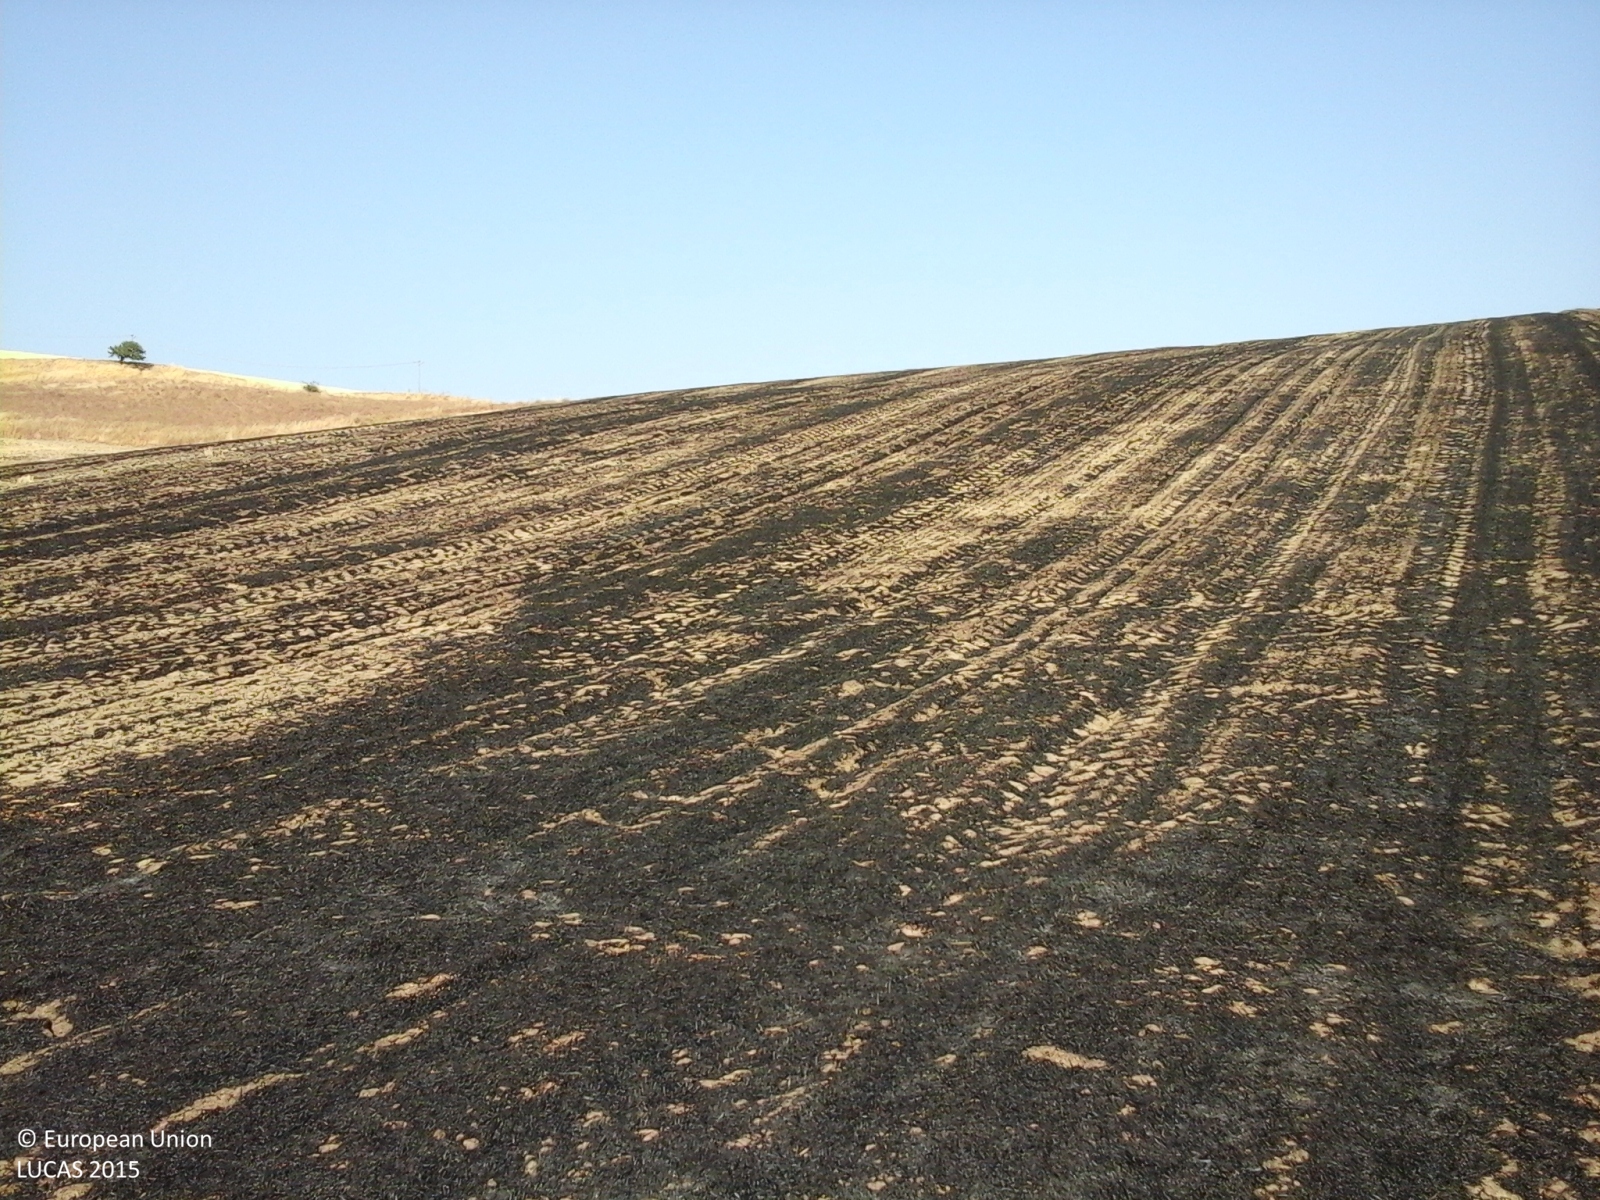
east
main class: Cropland
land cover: Common wheat
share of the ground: < 10 %
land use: Agriculture (excluding fallow land and kitchen gardens)
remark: Burnt area
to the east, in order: Common wheat; Sunflower; Spontaneously vegetated surfaces
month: July
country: IT
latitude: 41.9409
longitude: 14.8457
